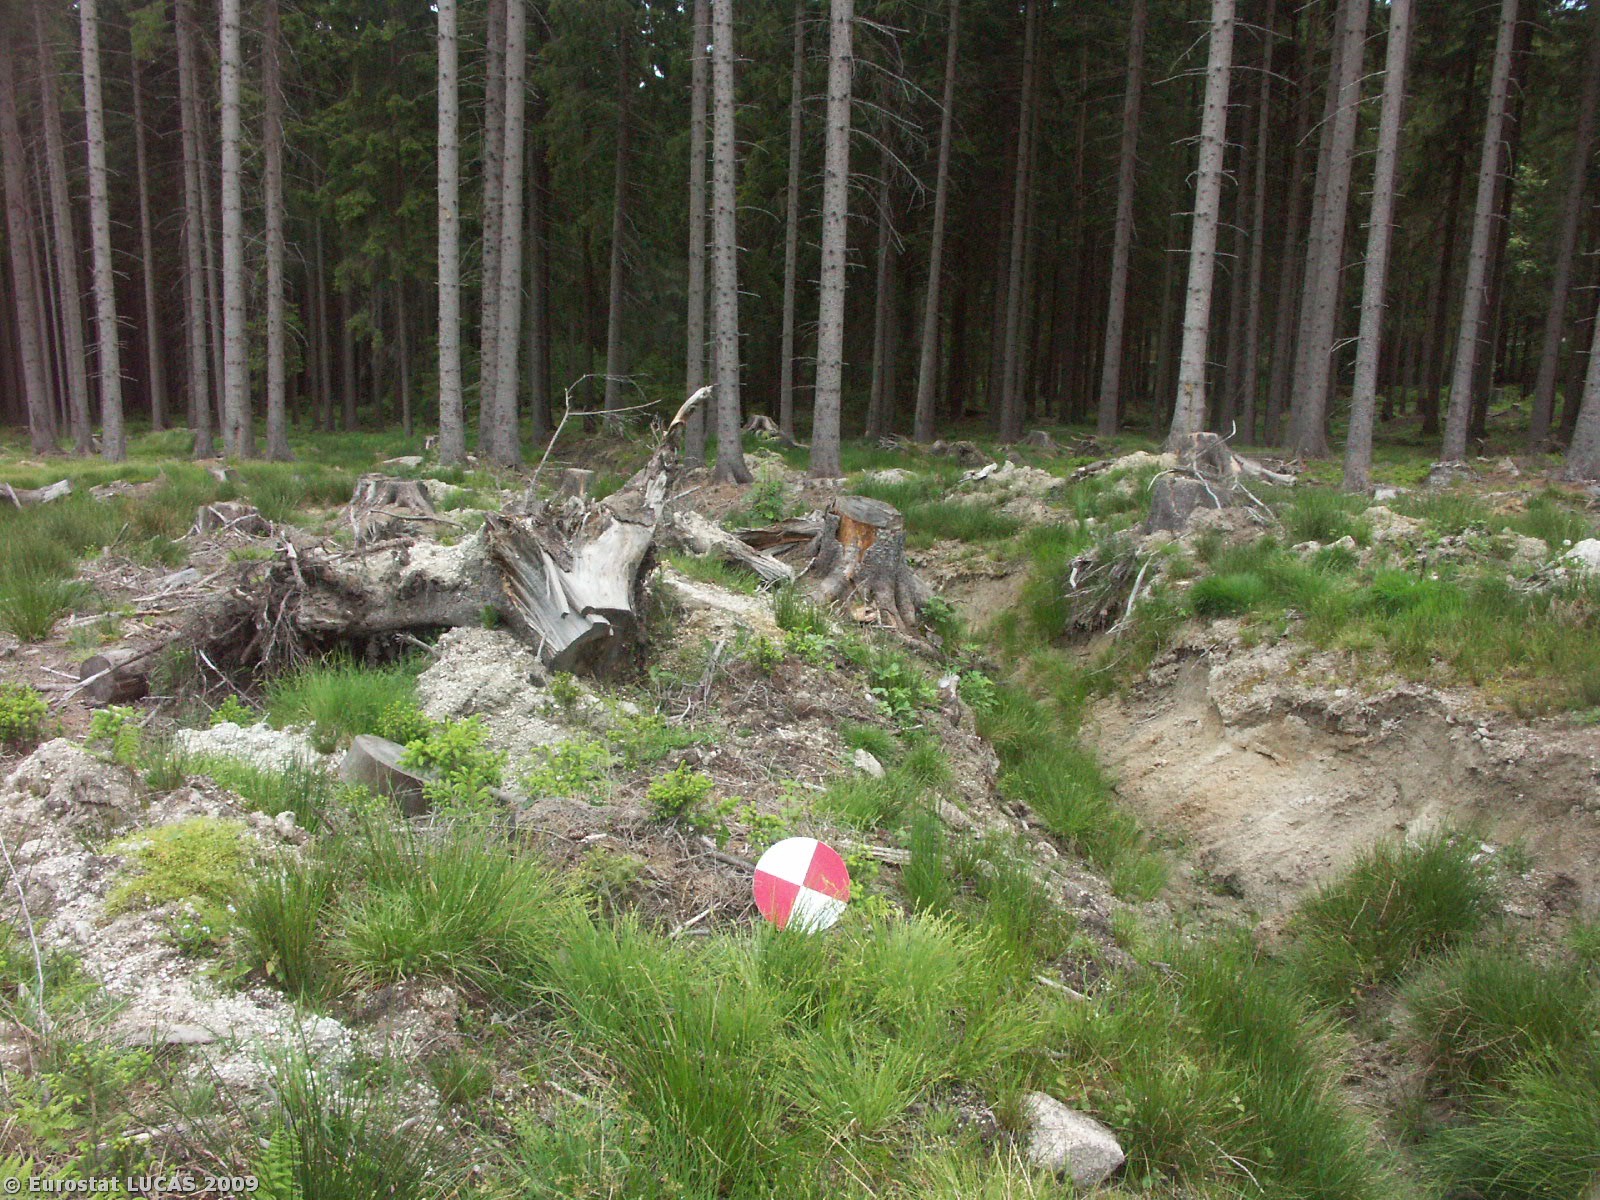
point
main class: Woodland
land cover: Coniferous woodland
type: hemiboreal forest and nemoral coniferous forest and mixed broadleaved-coniferous forest
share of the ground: 10 - 25 %
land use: Forestry
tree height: > 5 m
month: May
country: CZ
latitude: 48.7197
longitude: 14.6634
